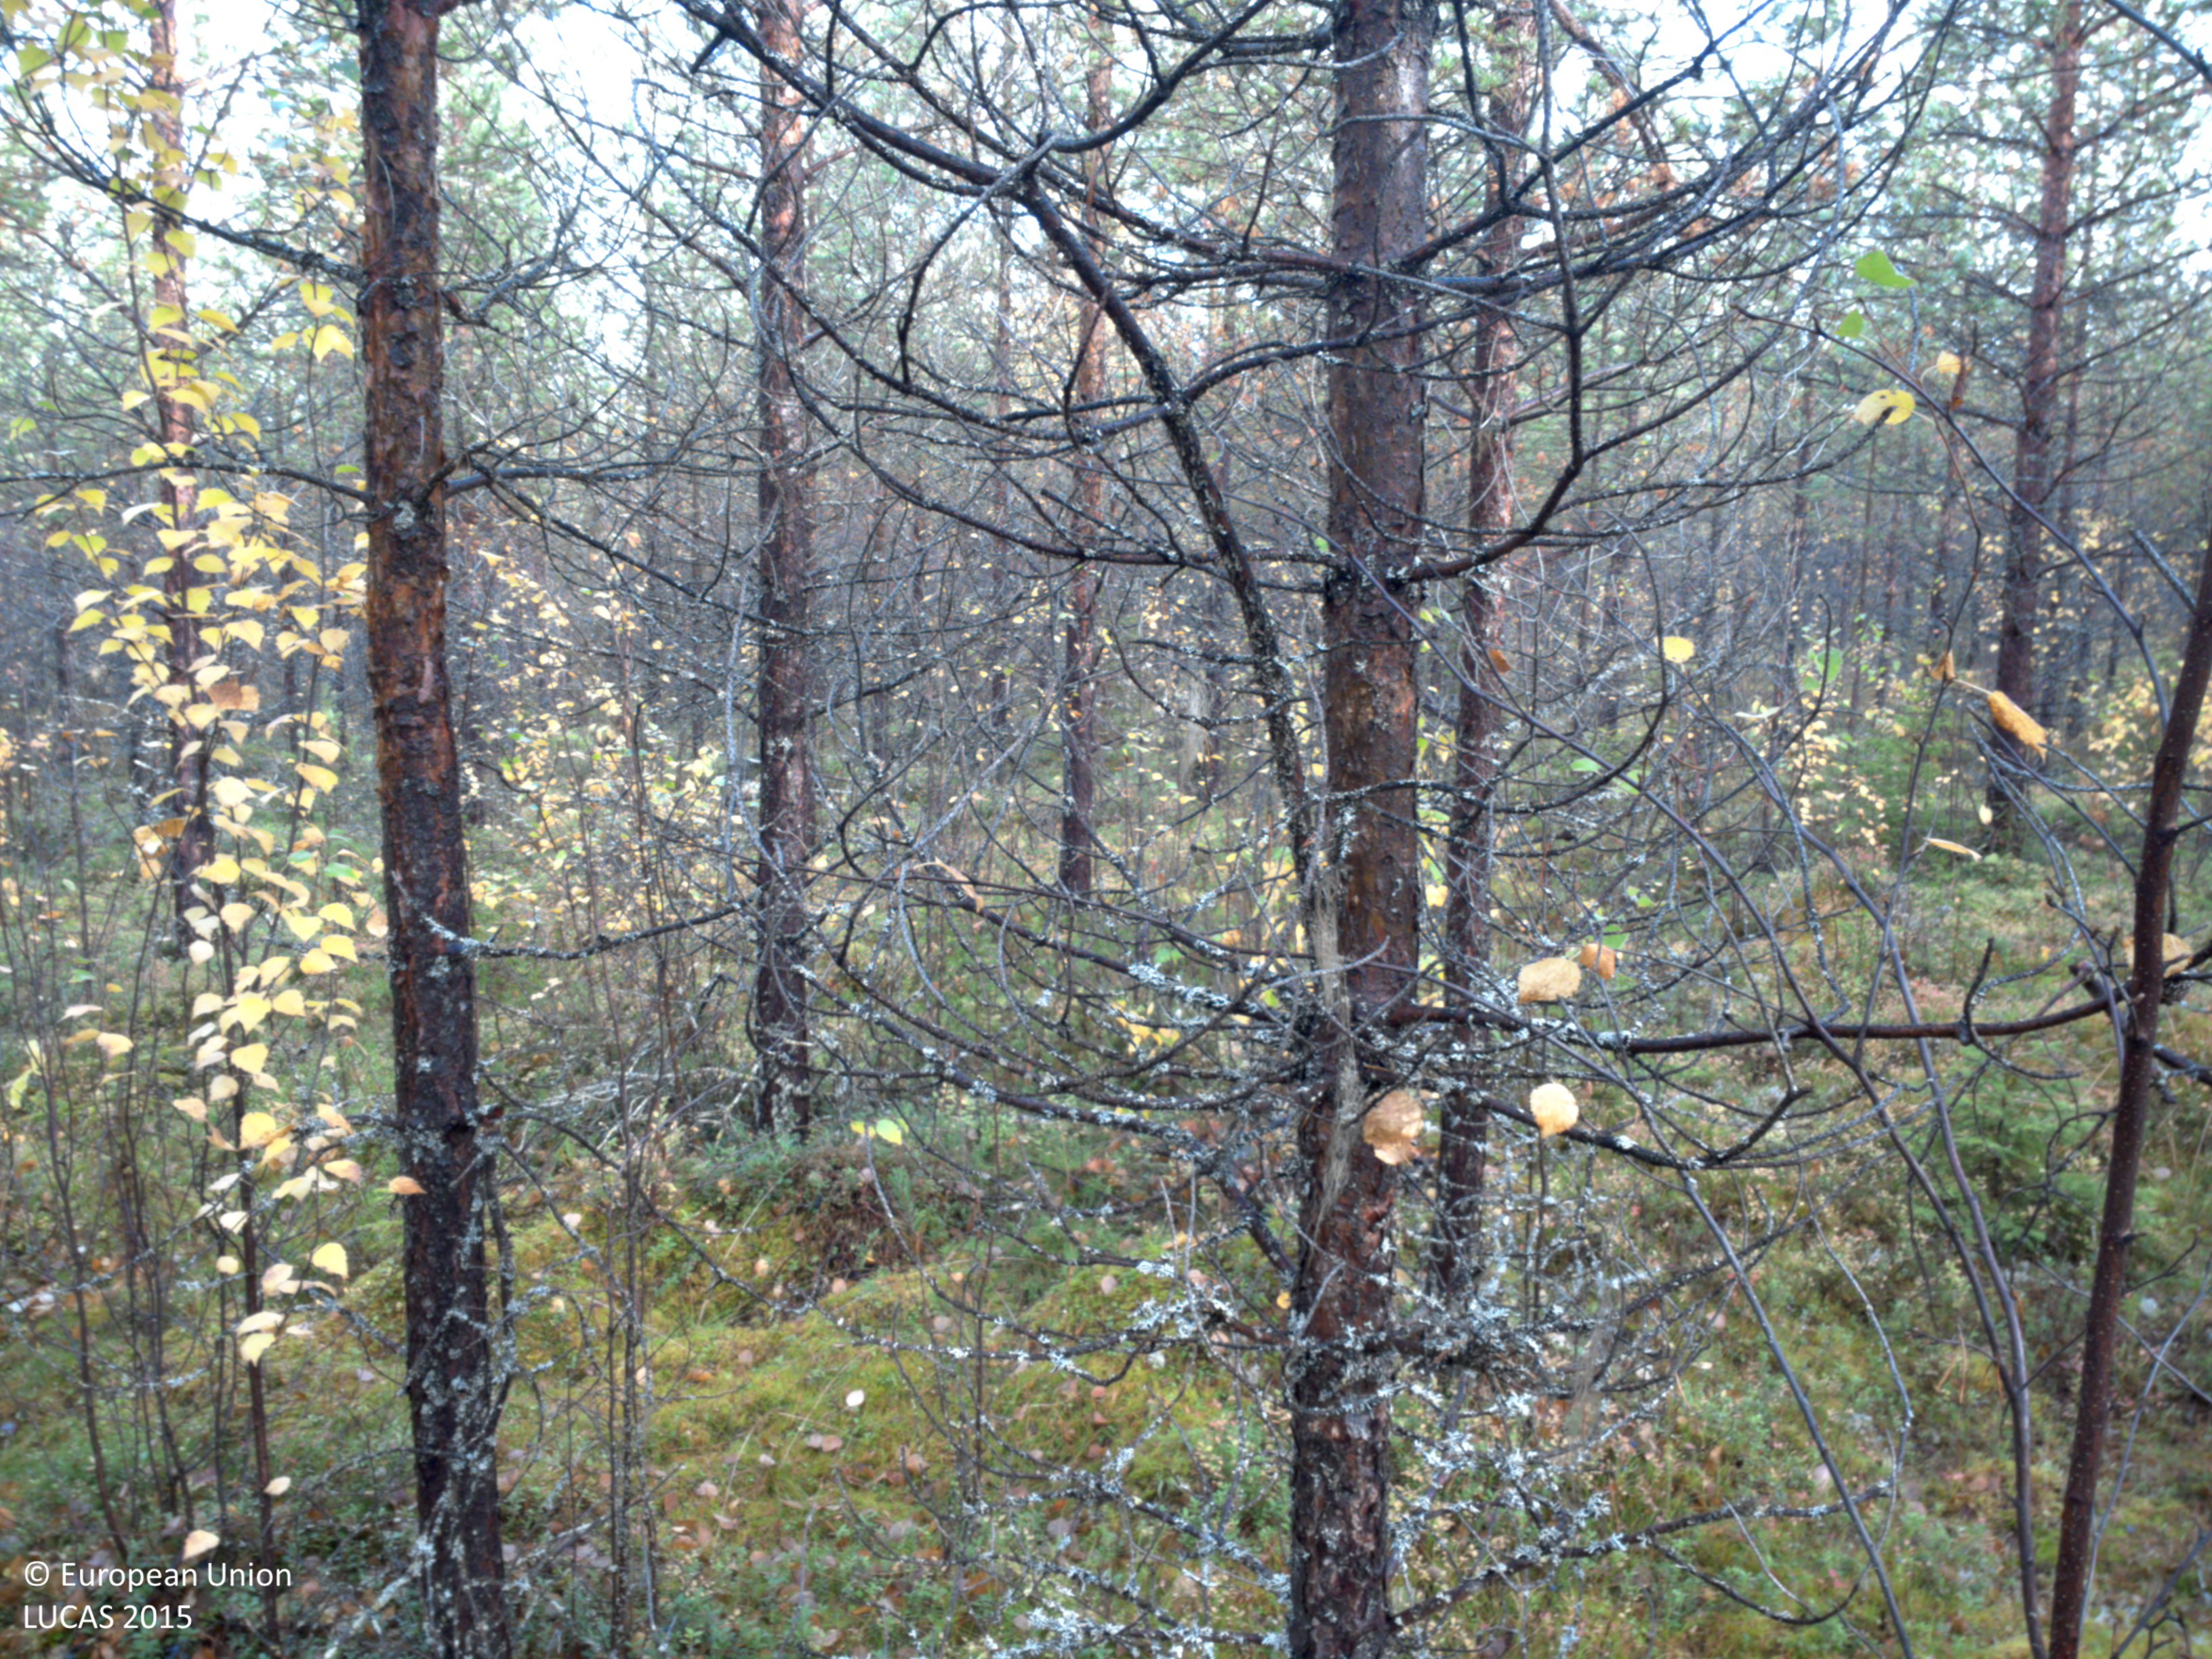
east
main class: Woodland
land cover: Pine dominated coniferous woodland
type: boreal forest
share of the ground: > 75 %
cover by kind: coniferous forest trees 75 %, shrubs 10 %, broadleaved forest trees 5 %, herbaceous plants 5 %, lichens and mosses 5 %
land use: Forestry
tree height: > 5 m
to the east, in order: Pine dominated coniferous woodland; Pine dominated mixed woodland; Shrubland with sparse tree cover; Ditches and canals; Paved roads, cycling and walking lanes; Other coniferous woodland; Ditches and canals; Pine dominated mixed woodland; Pine dominated coniferous woodland
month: September
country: SE
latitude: 64.7215
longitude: 19.0560
